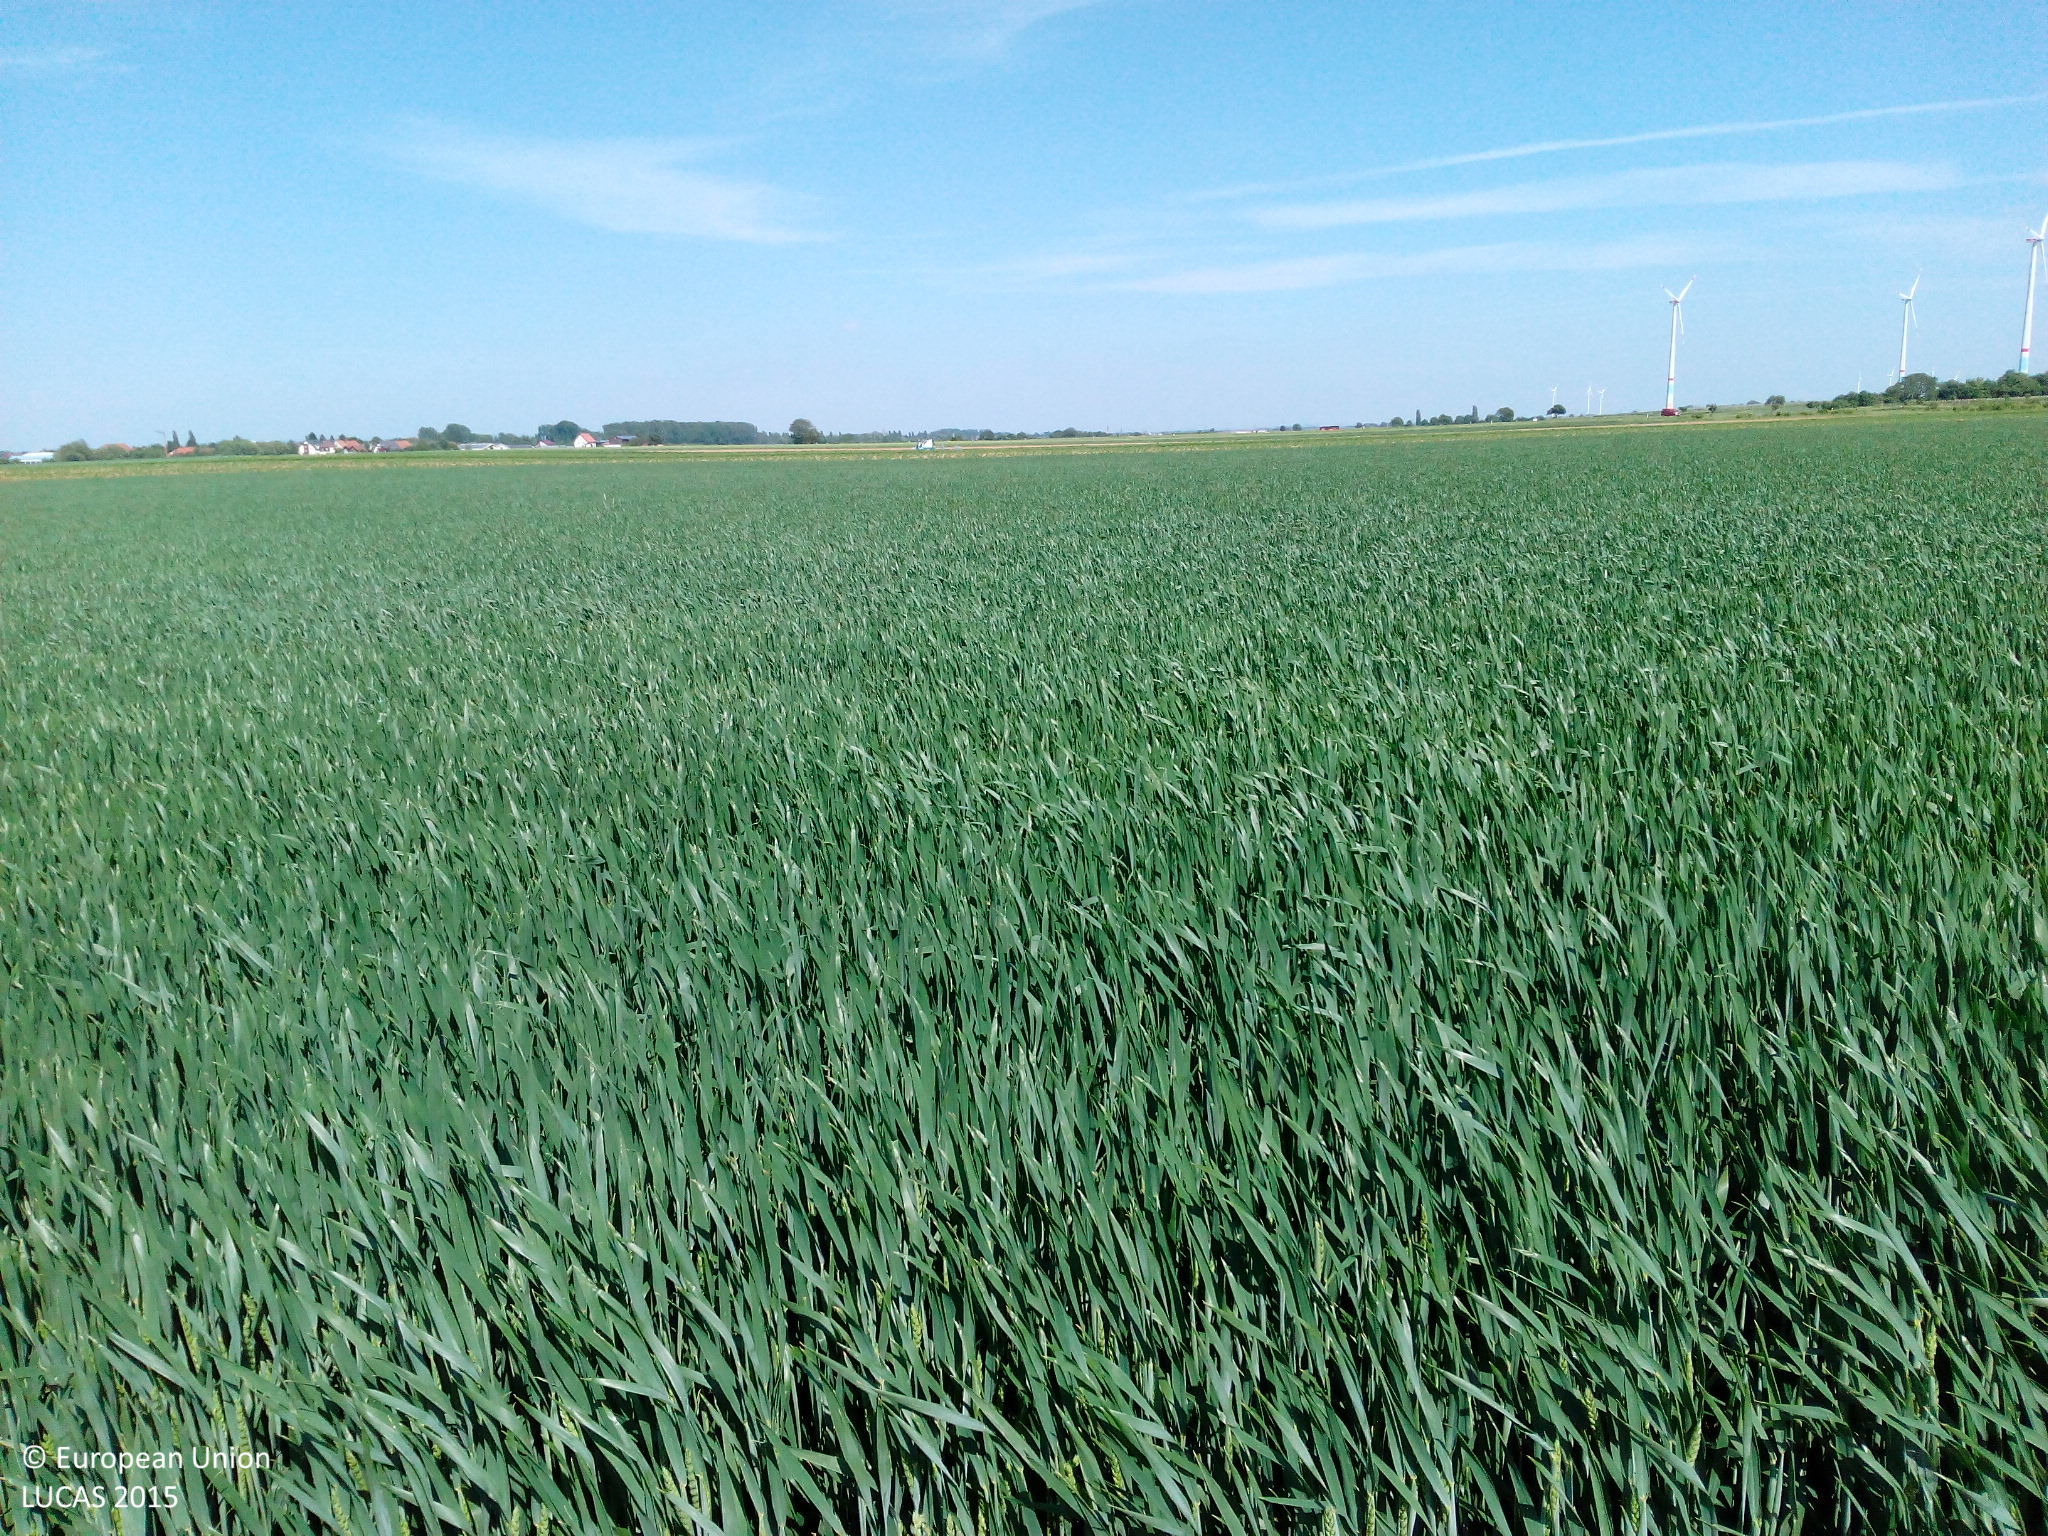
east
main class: Cropland
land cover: Common wheat
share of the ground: > 75 %
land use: Agriculture (excluding fallow land and kitchen gardens)
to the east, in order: Common wheat; Potatoes; Other fresh vegetables; Other bare soil
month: May
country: DE
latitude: 49.1802
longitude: 8.1760
